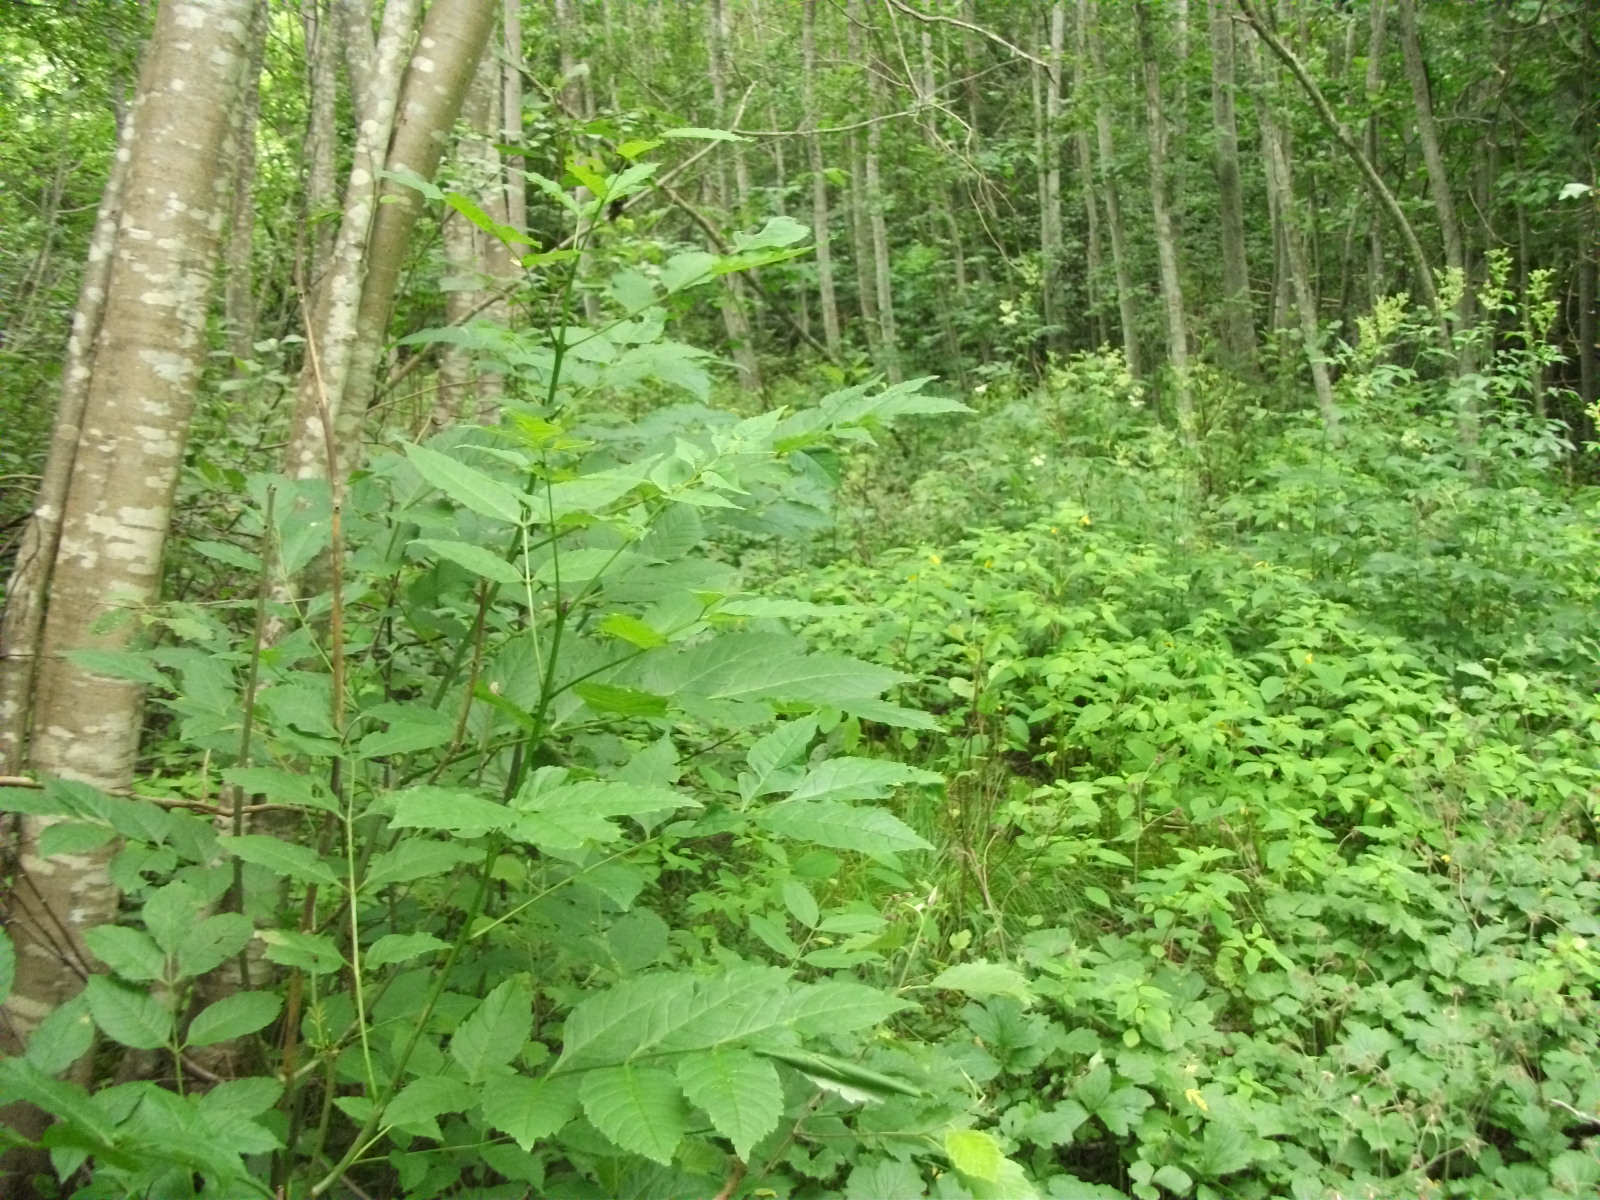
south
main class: Woodland
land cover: Broadleaved woodland
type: non-riverine alder, birch or aspen forest
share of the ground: > 75 %
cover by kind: broadleaved forest trees 90 %, herbaceous plants 10 %
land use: Forestry
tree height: > 5 m
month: July
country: LV
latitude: 56.9946
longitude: 26.2868
